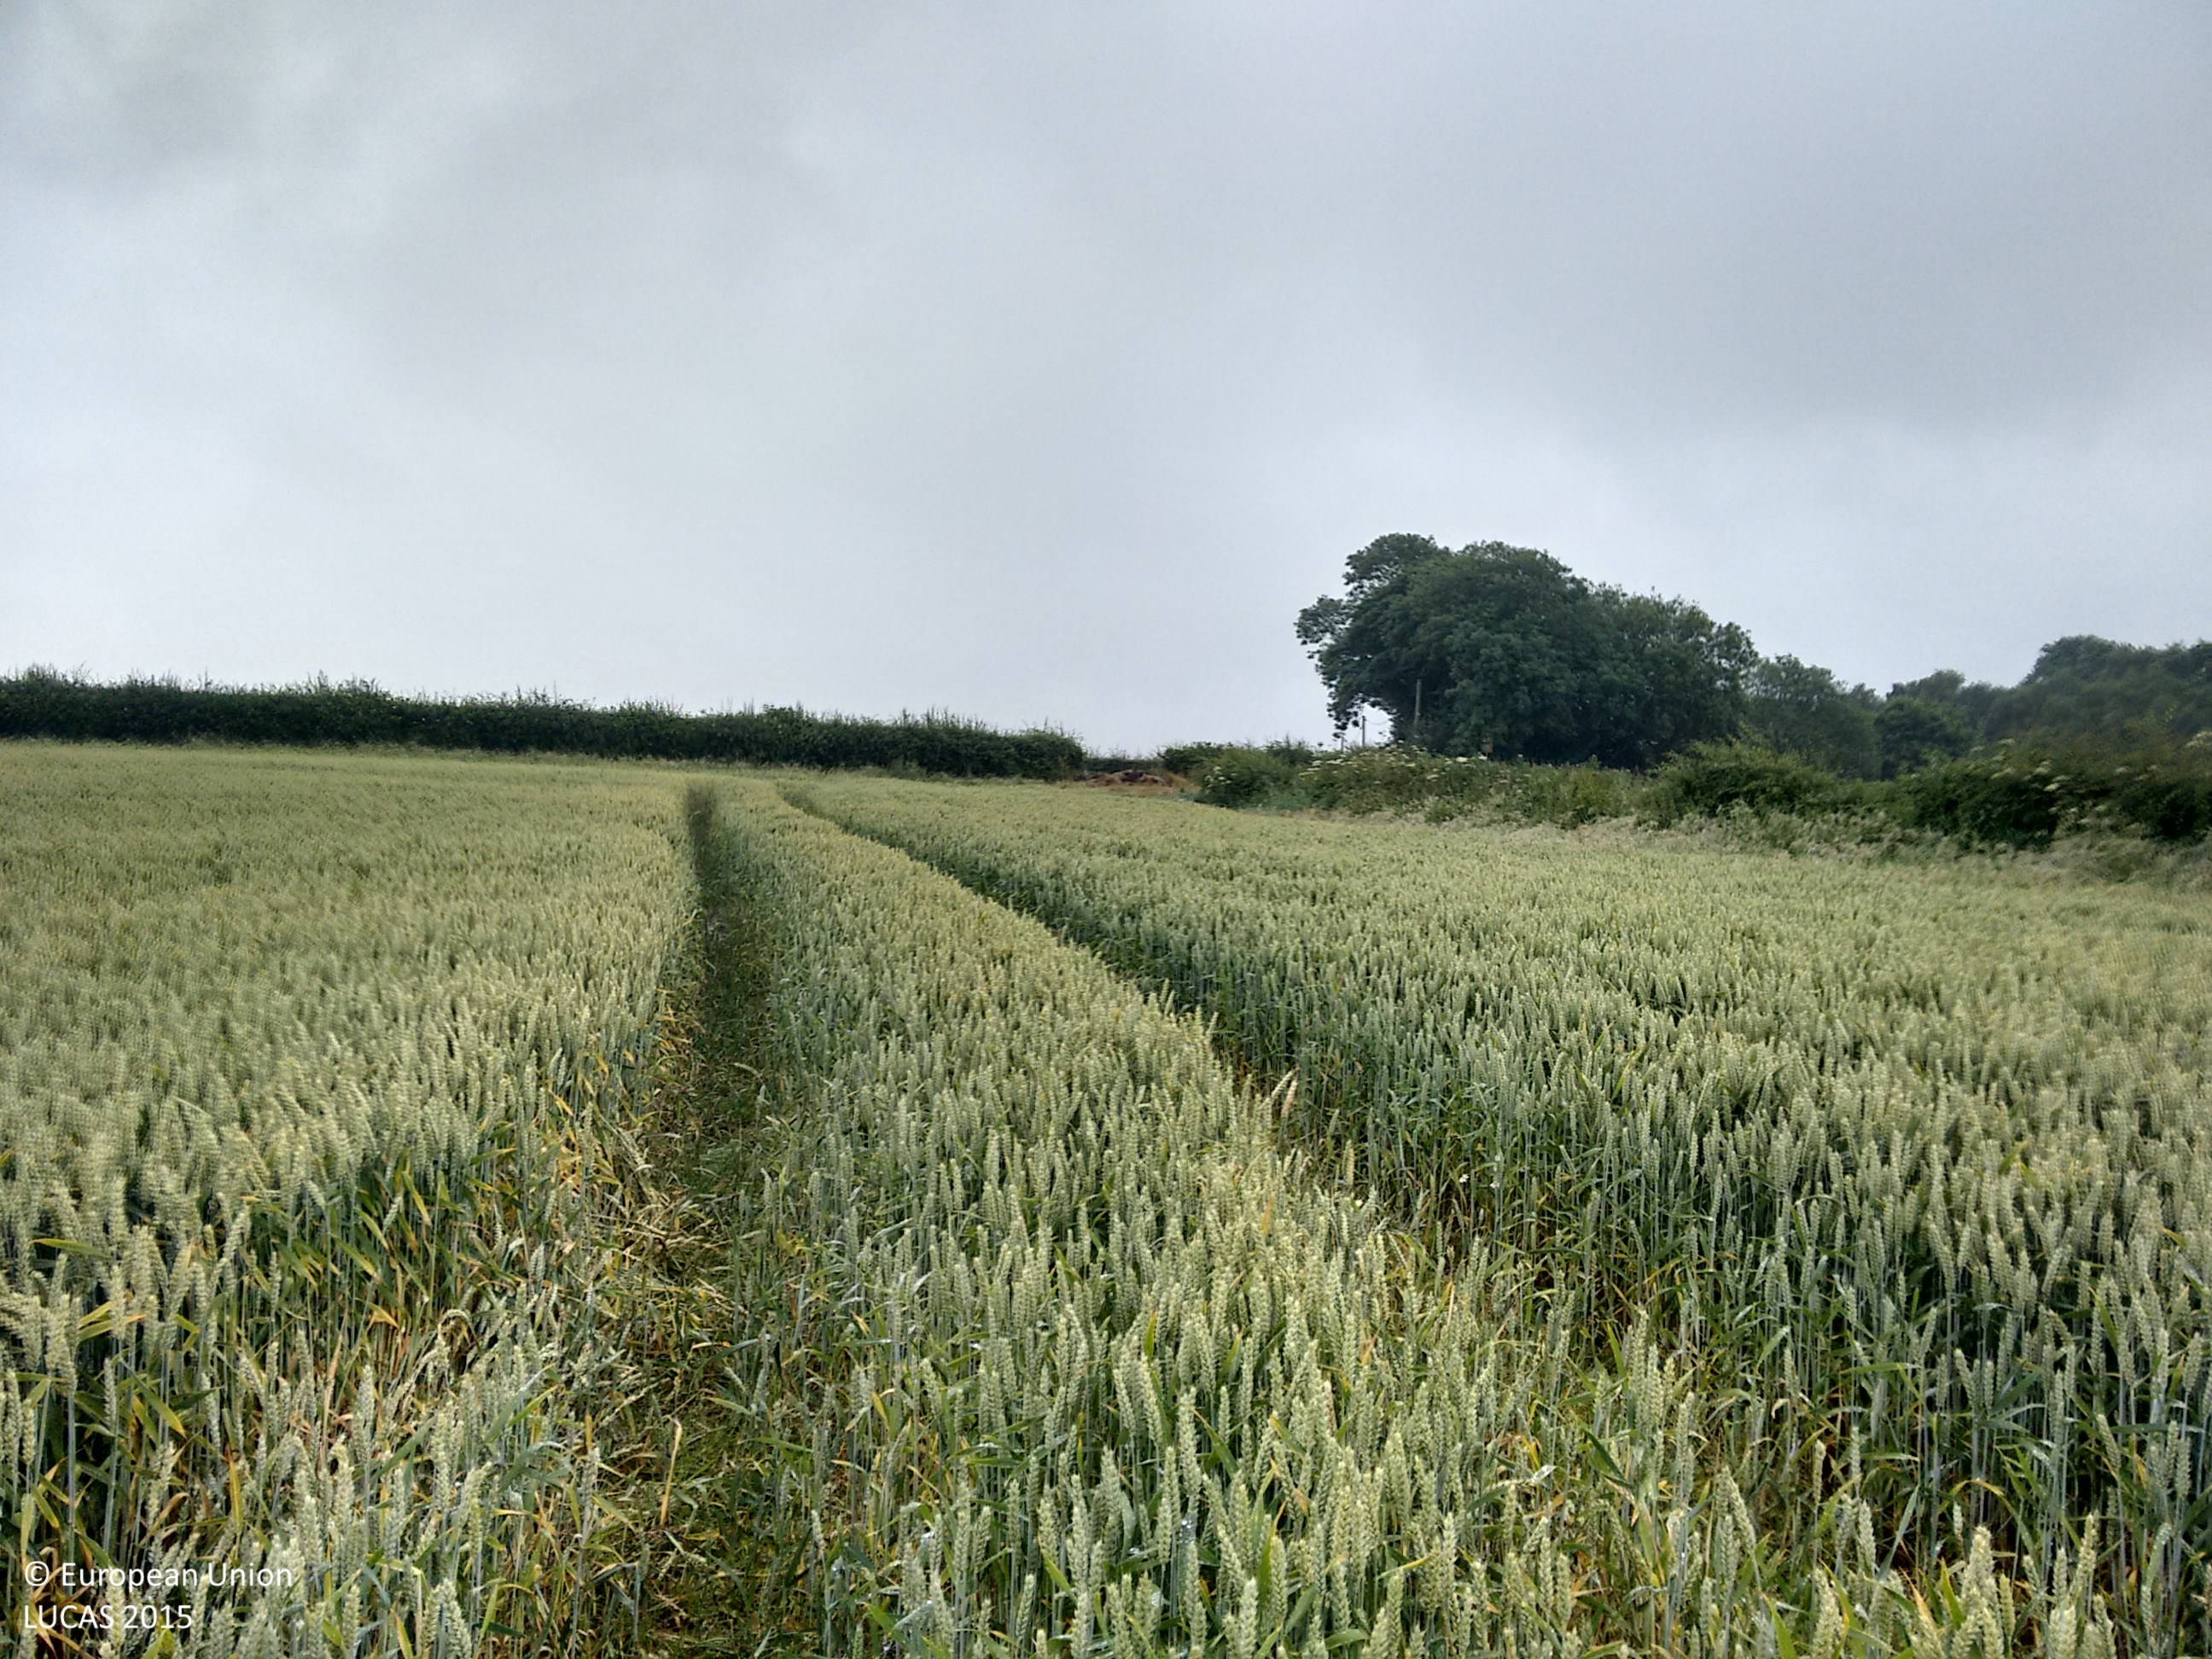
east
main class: Cropland
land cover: Common wheat
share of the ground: > 75 %
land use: Agriculture (excluding fallow land and kitchen gardens)
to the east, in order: Common wheat; Grass margins; Managed hedges; Grass margins; Paved roads, cycling and walking lanes; Managed hedges; Oats; Managed hedges; Oats; Electric lines; Oats
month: July
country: GB
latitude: 53.4483
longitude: -2.7938
